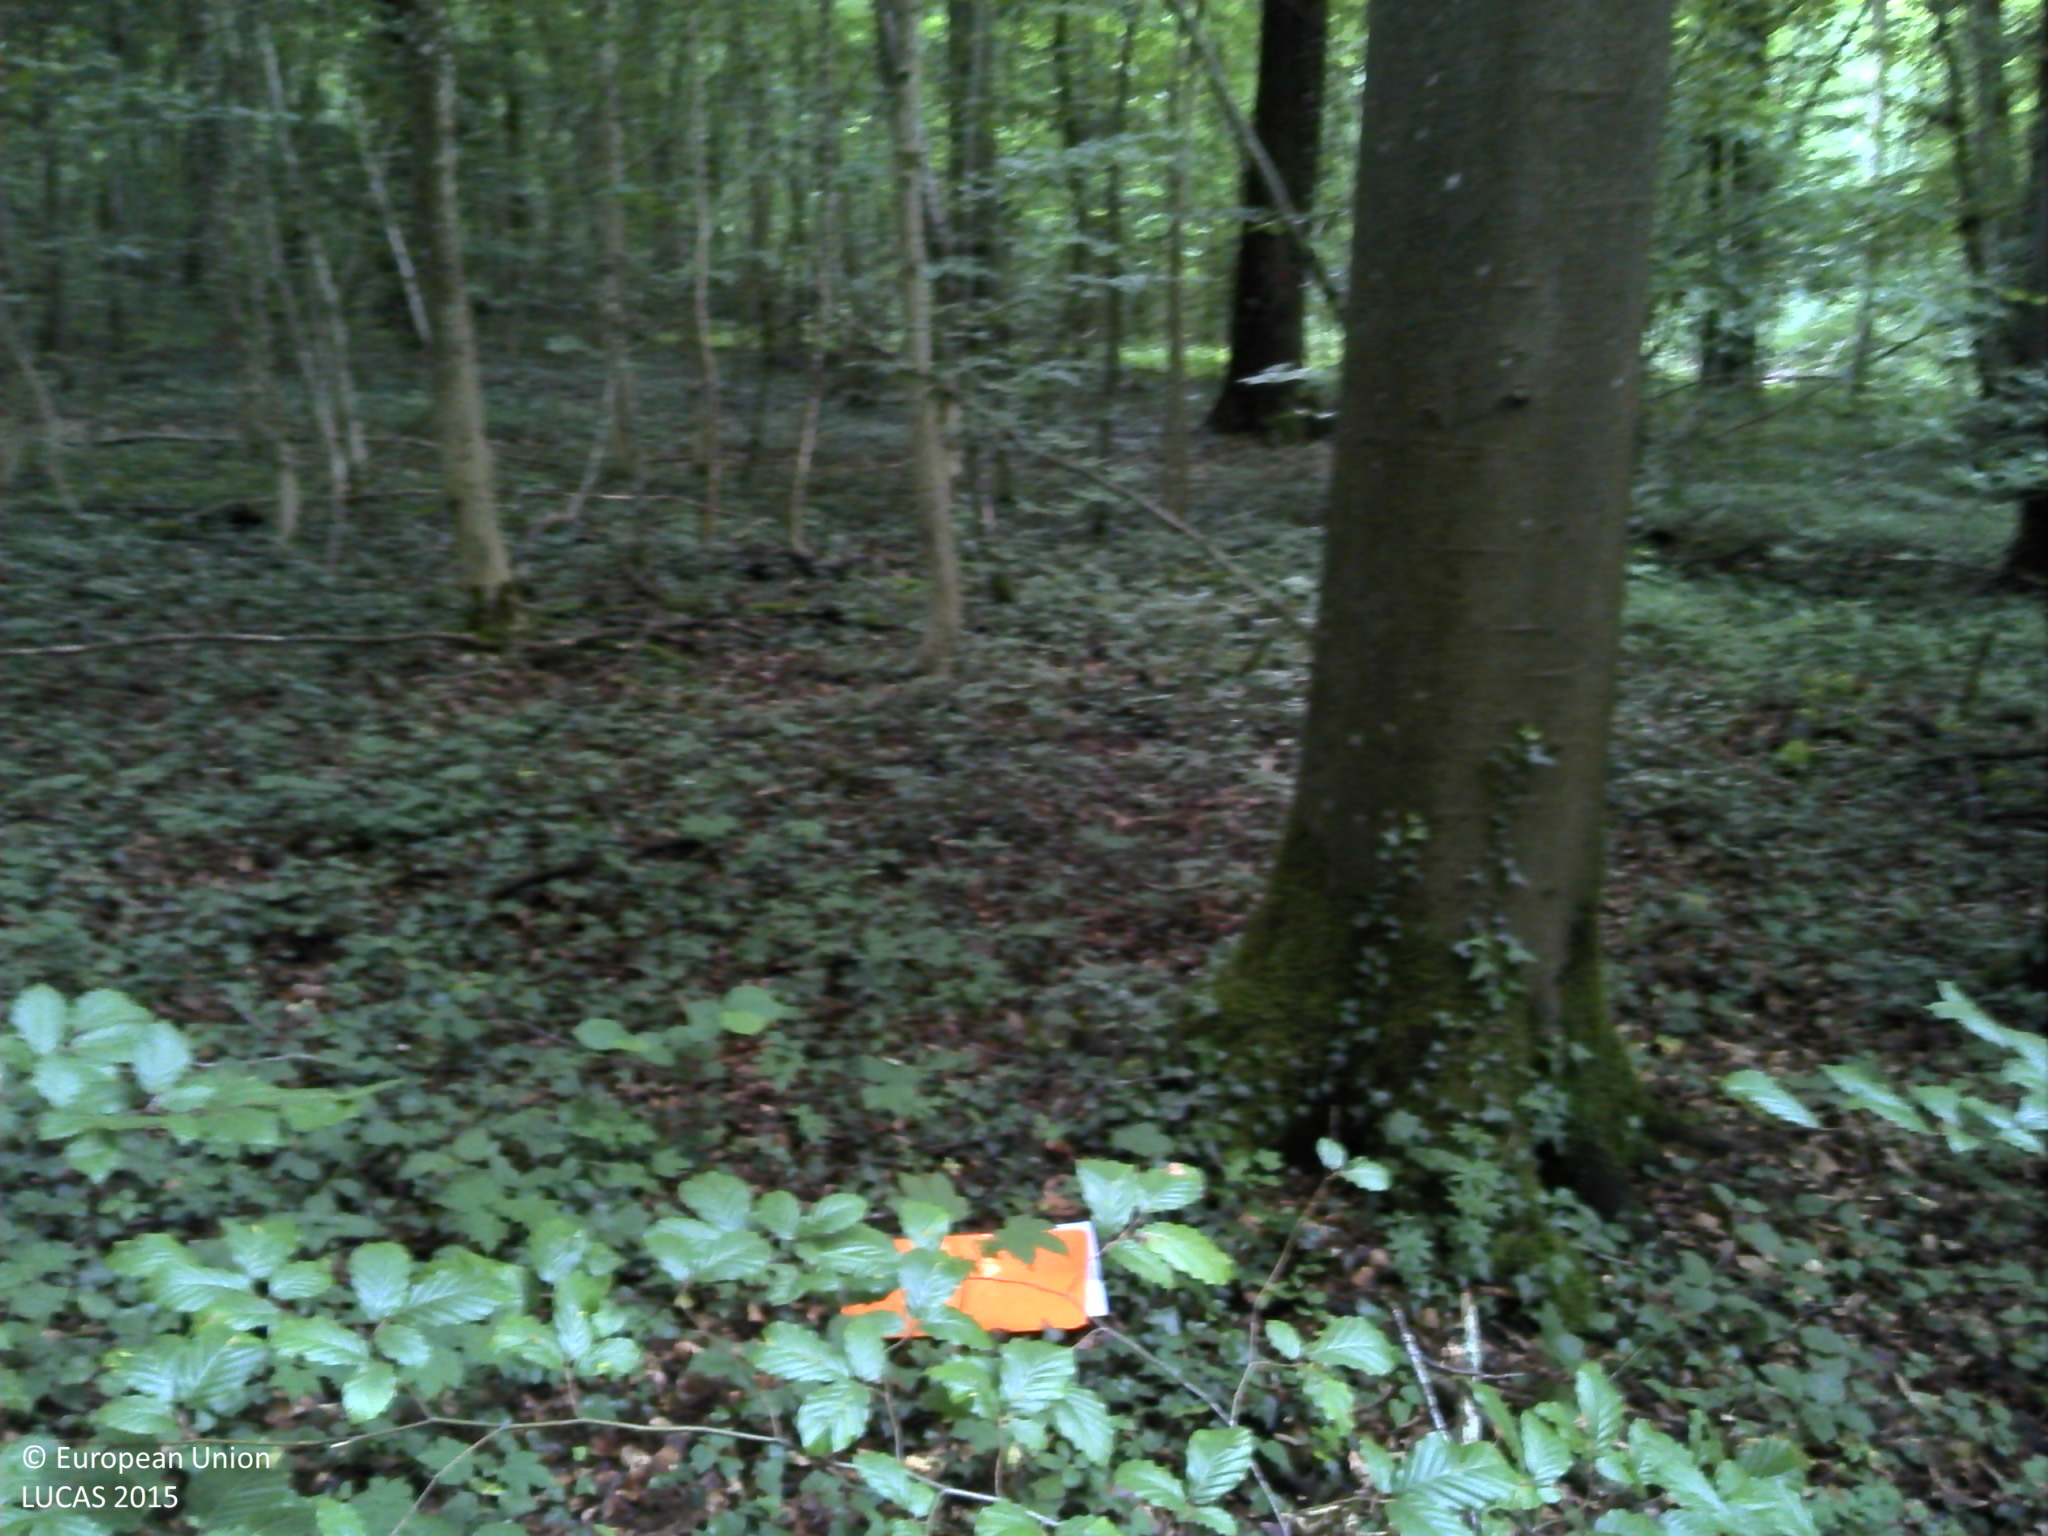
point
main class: Woodland
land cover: Broadleaved woodland
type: beech forest
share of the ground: > 75 %
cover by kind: broadleaved forest trees 70 %, herbaceous plants 20 %, lichens and mosses 5 %, consolidated bare surface 5 %
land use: Forestry
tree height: > 5 m
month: June
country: FR
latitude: 49.6487
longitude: 4.7476
